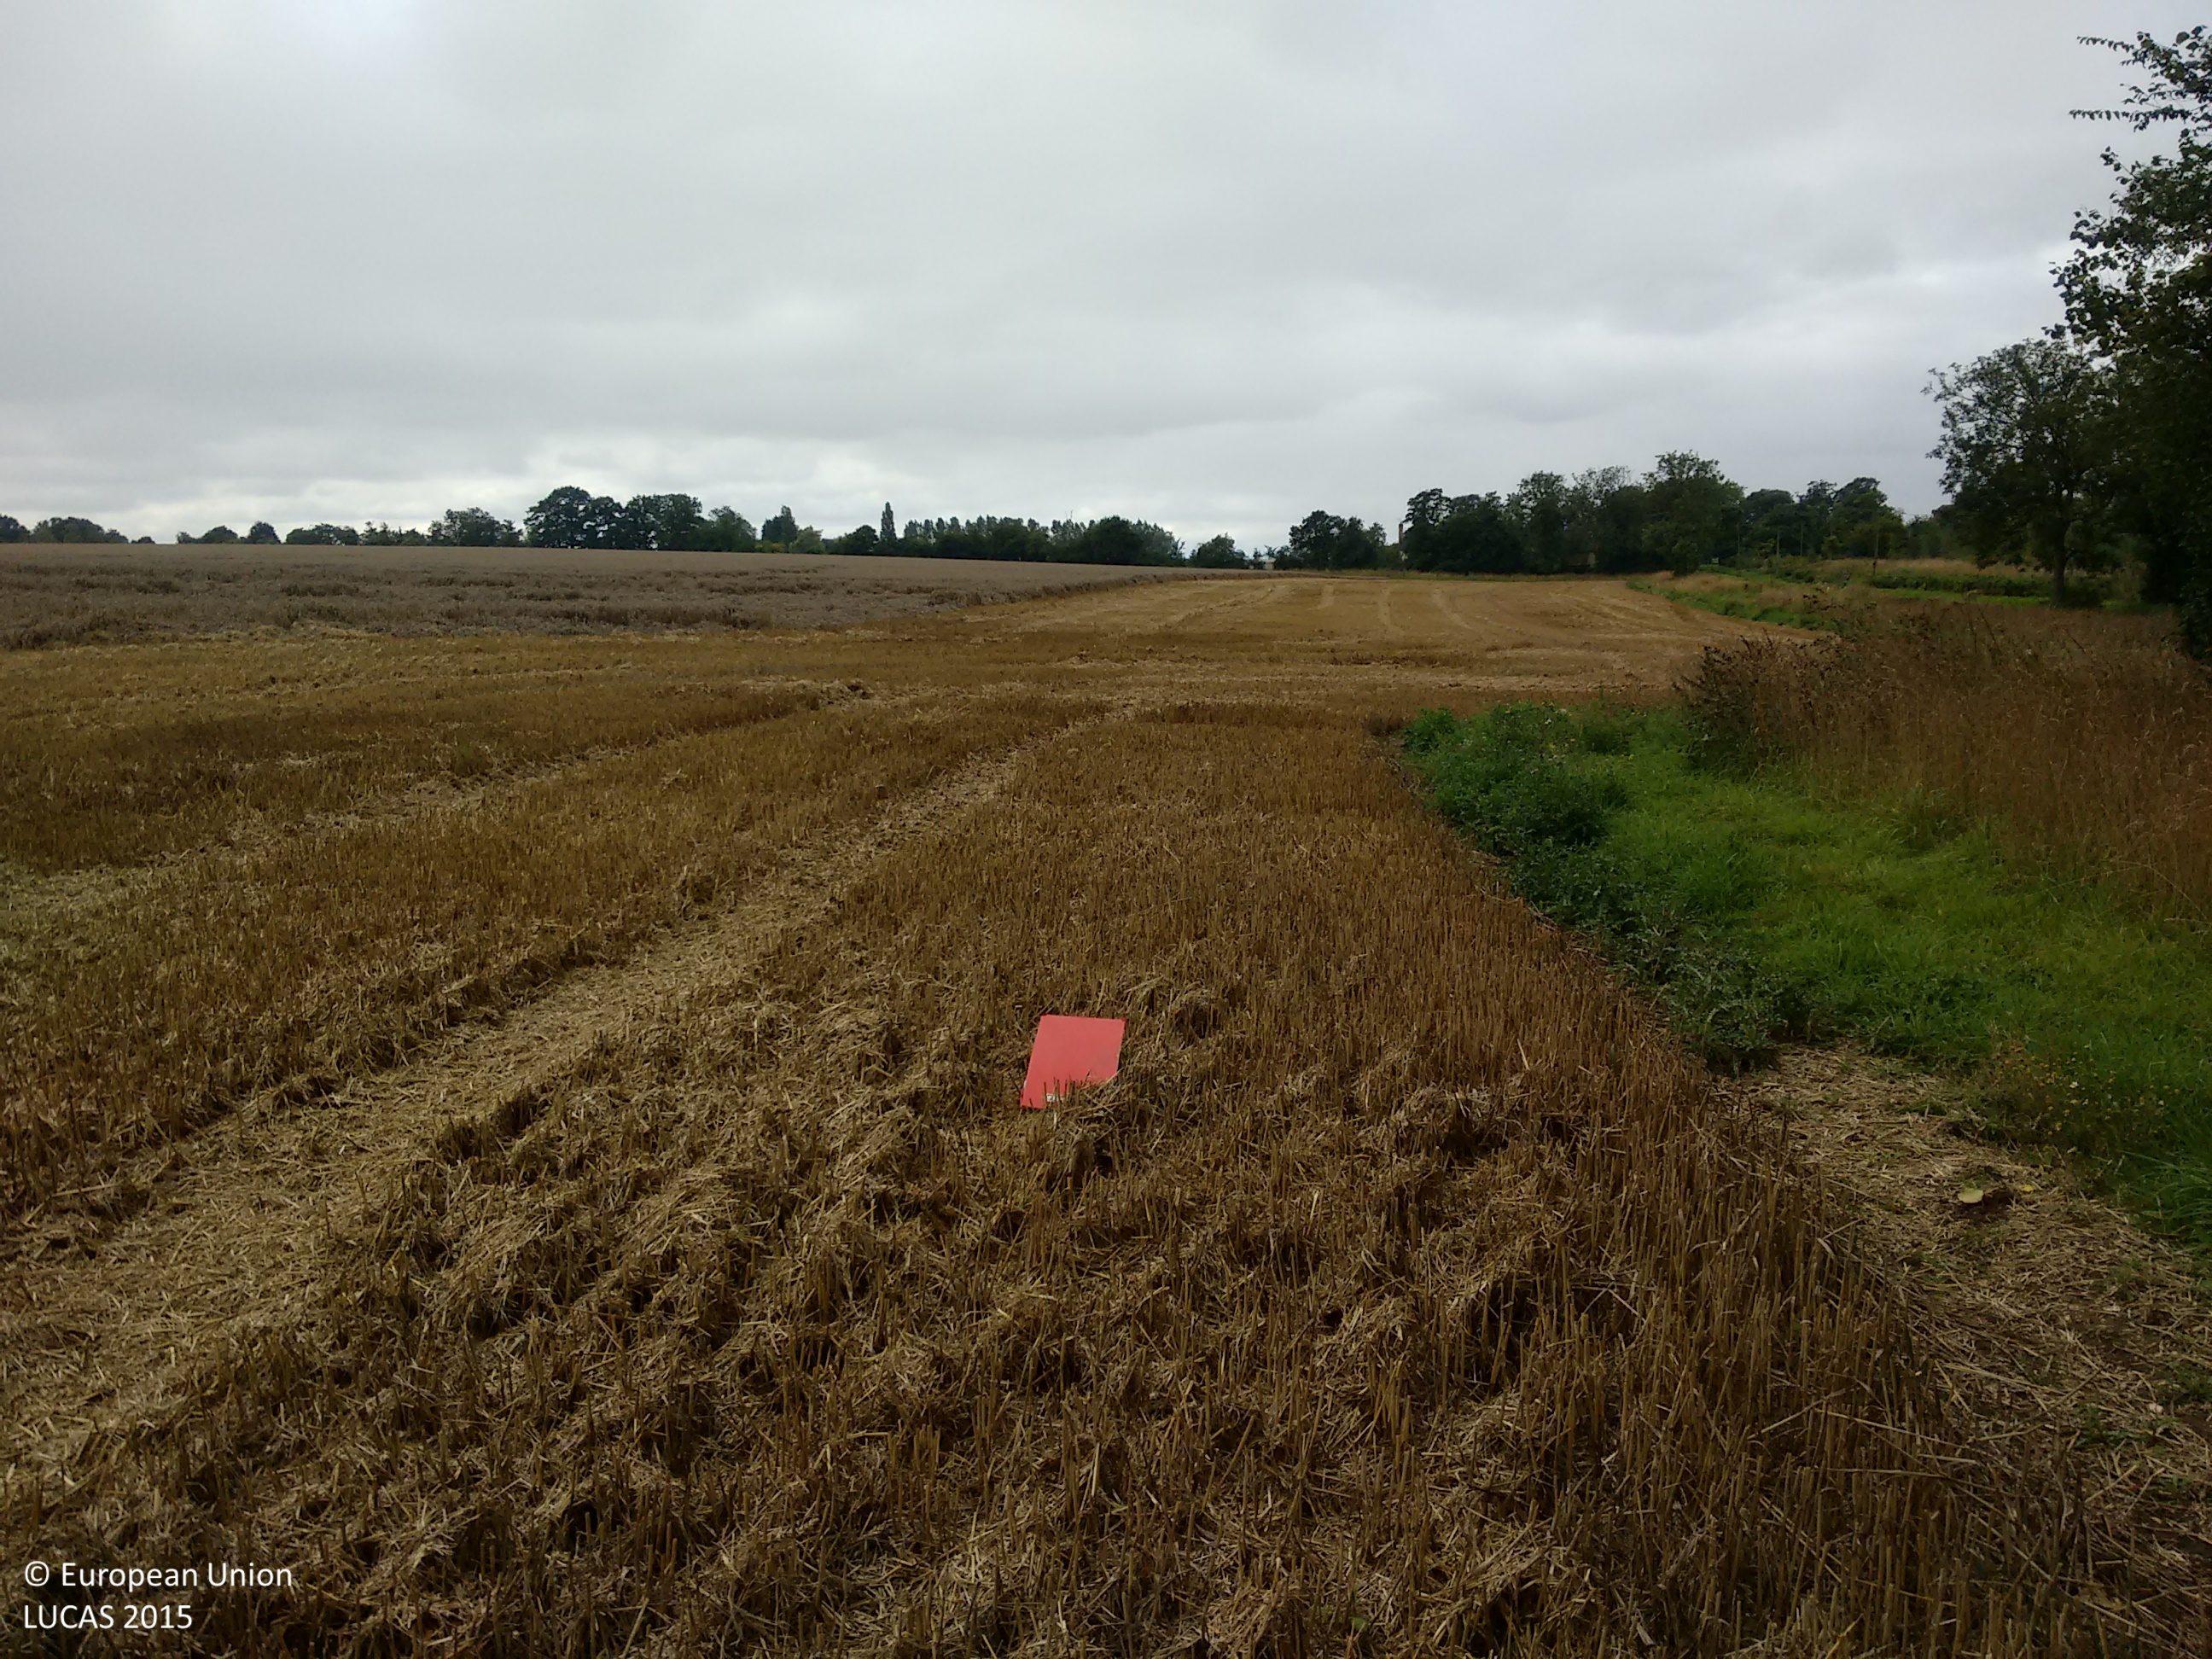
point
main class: Cropland
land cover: Common wheat
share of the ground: > 75 %
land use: Agriculture (excluding fallow land and kitchen gardens)
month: September
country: GB
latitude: 52.1740
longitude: 0.9247
